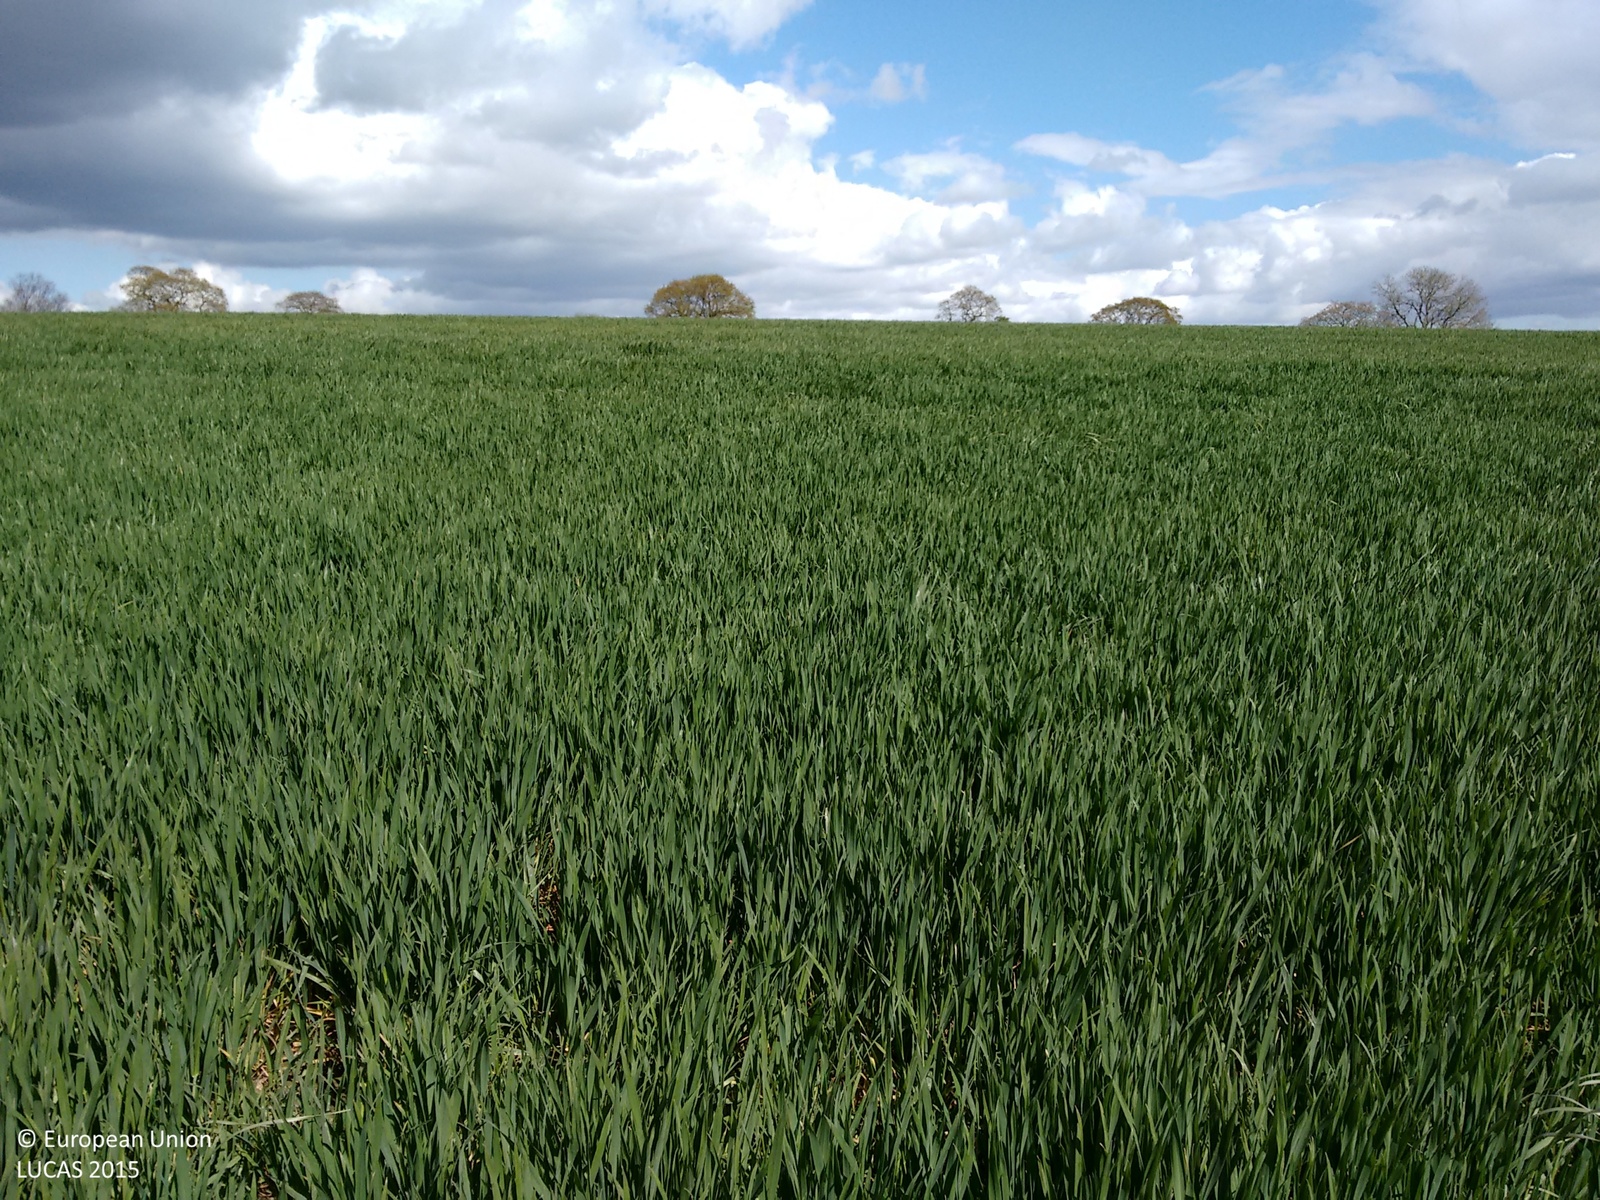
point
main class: Cropland
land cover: Common wheat
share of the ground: > 75 %
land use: Agriculture (excluding fallow land and kitchen gardens)
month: April
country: GB
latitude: 54.9786
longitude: -1.8807
